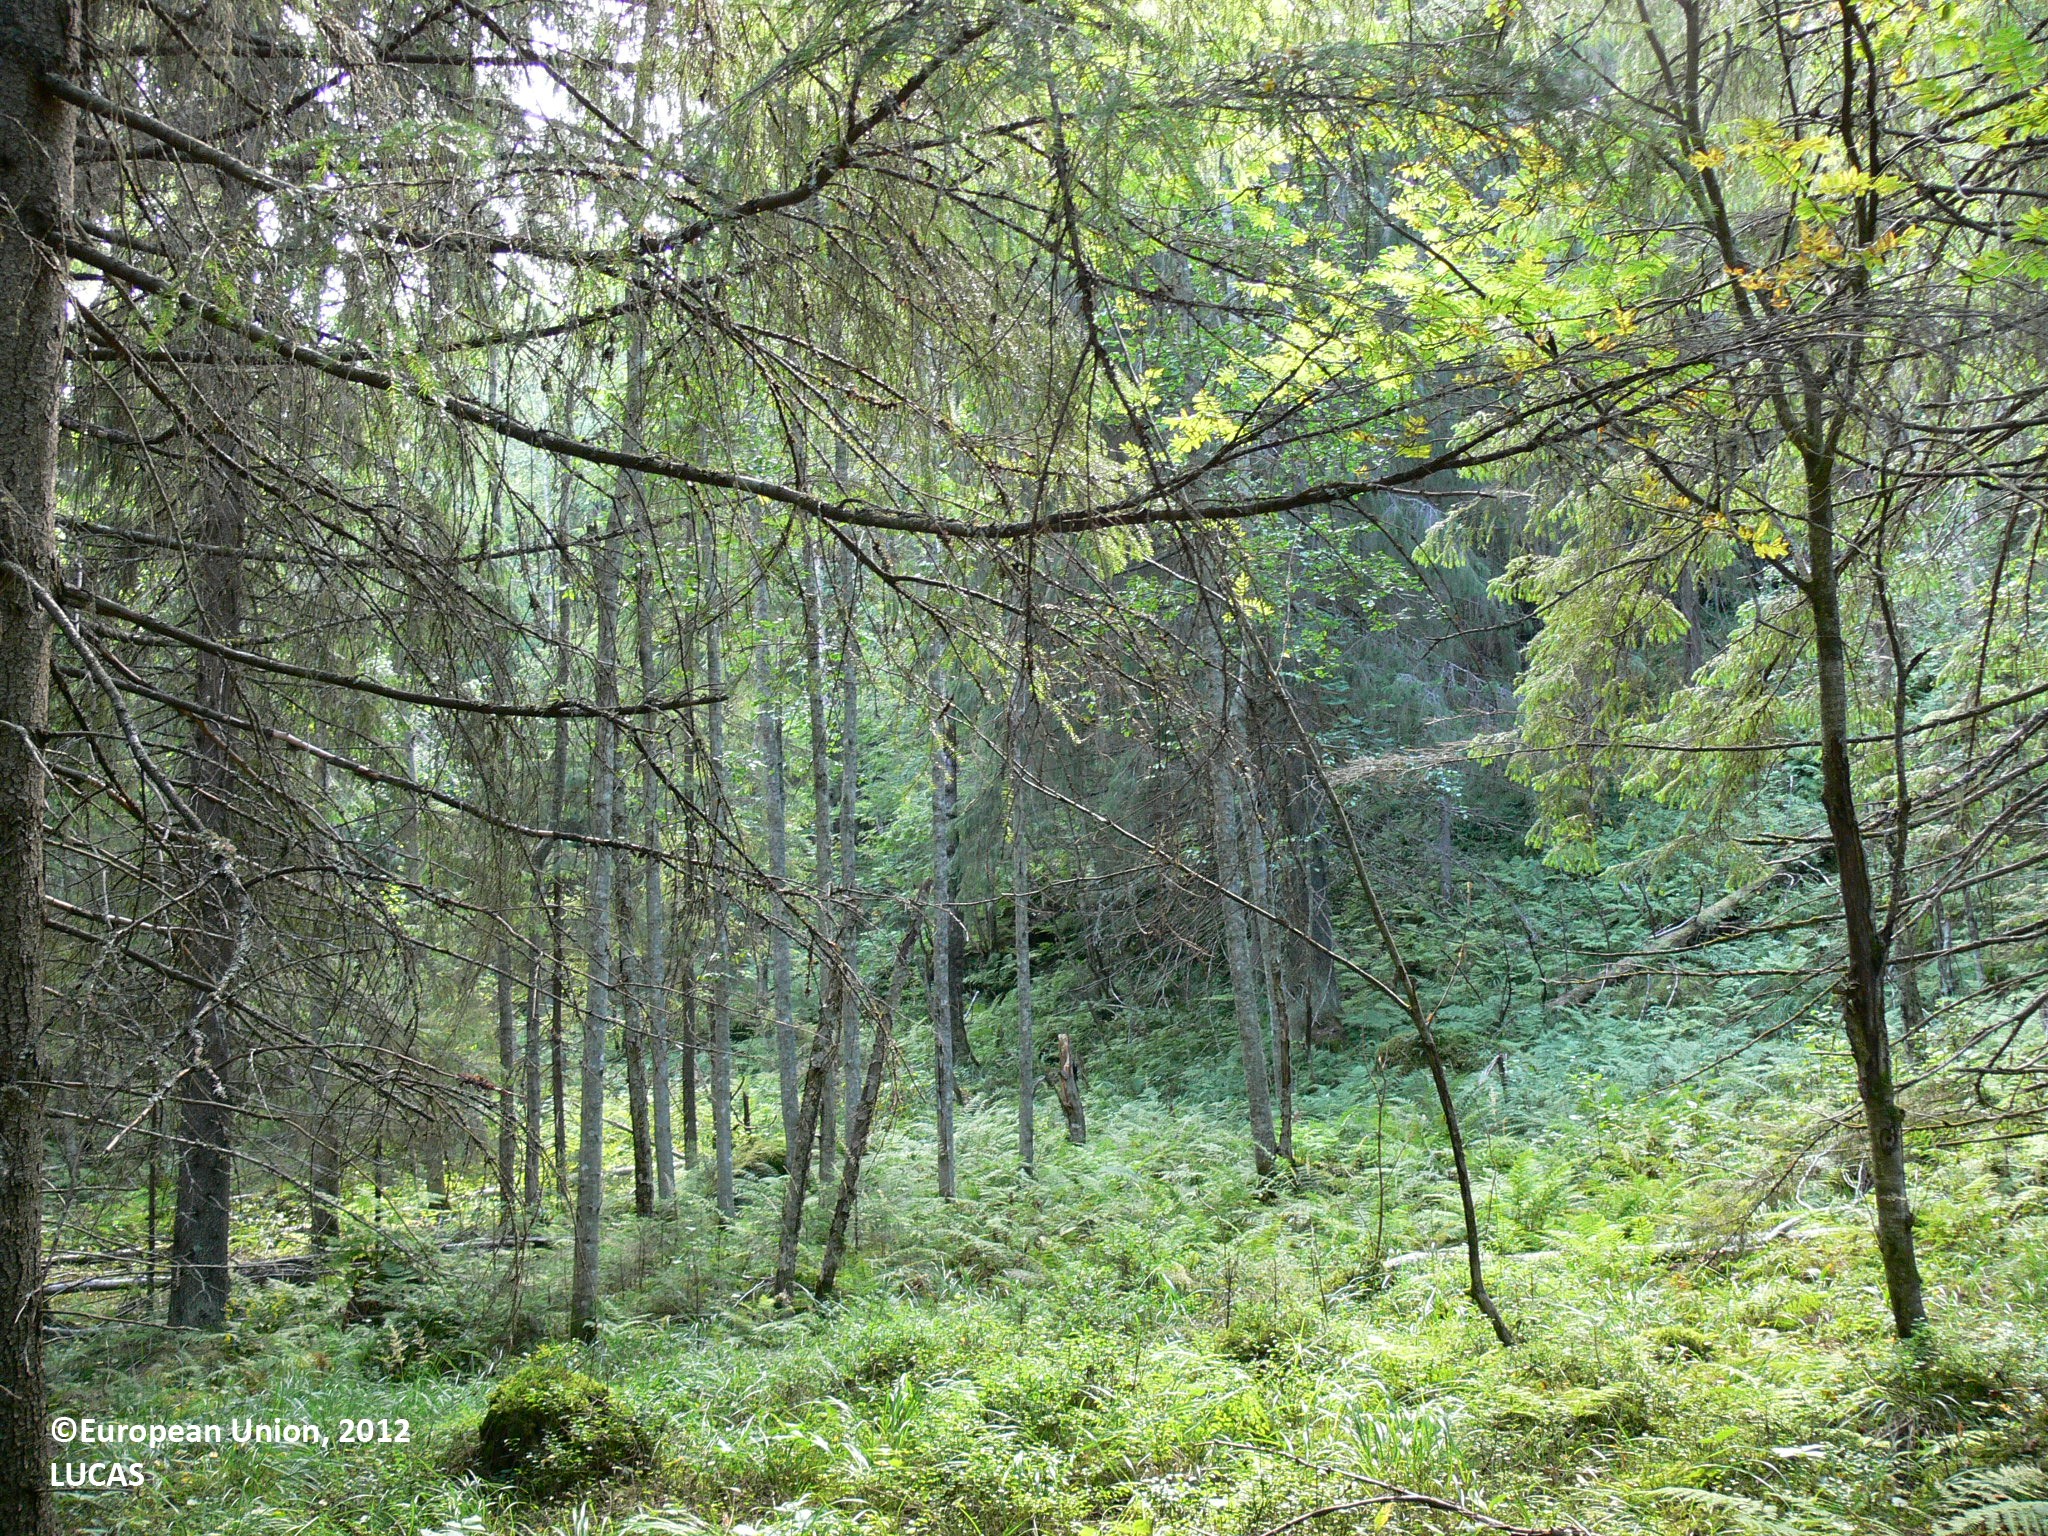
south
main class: Woodland
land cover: Spruce dominated mixed woodland
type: boreal forest
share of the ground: > 75 %
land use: Semi-natural and natural areas not in use
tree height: > 5 m
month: August
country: FI
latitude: 63.0866
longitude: 29.8305
